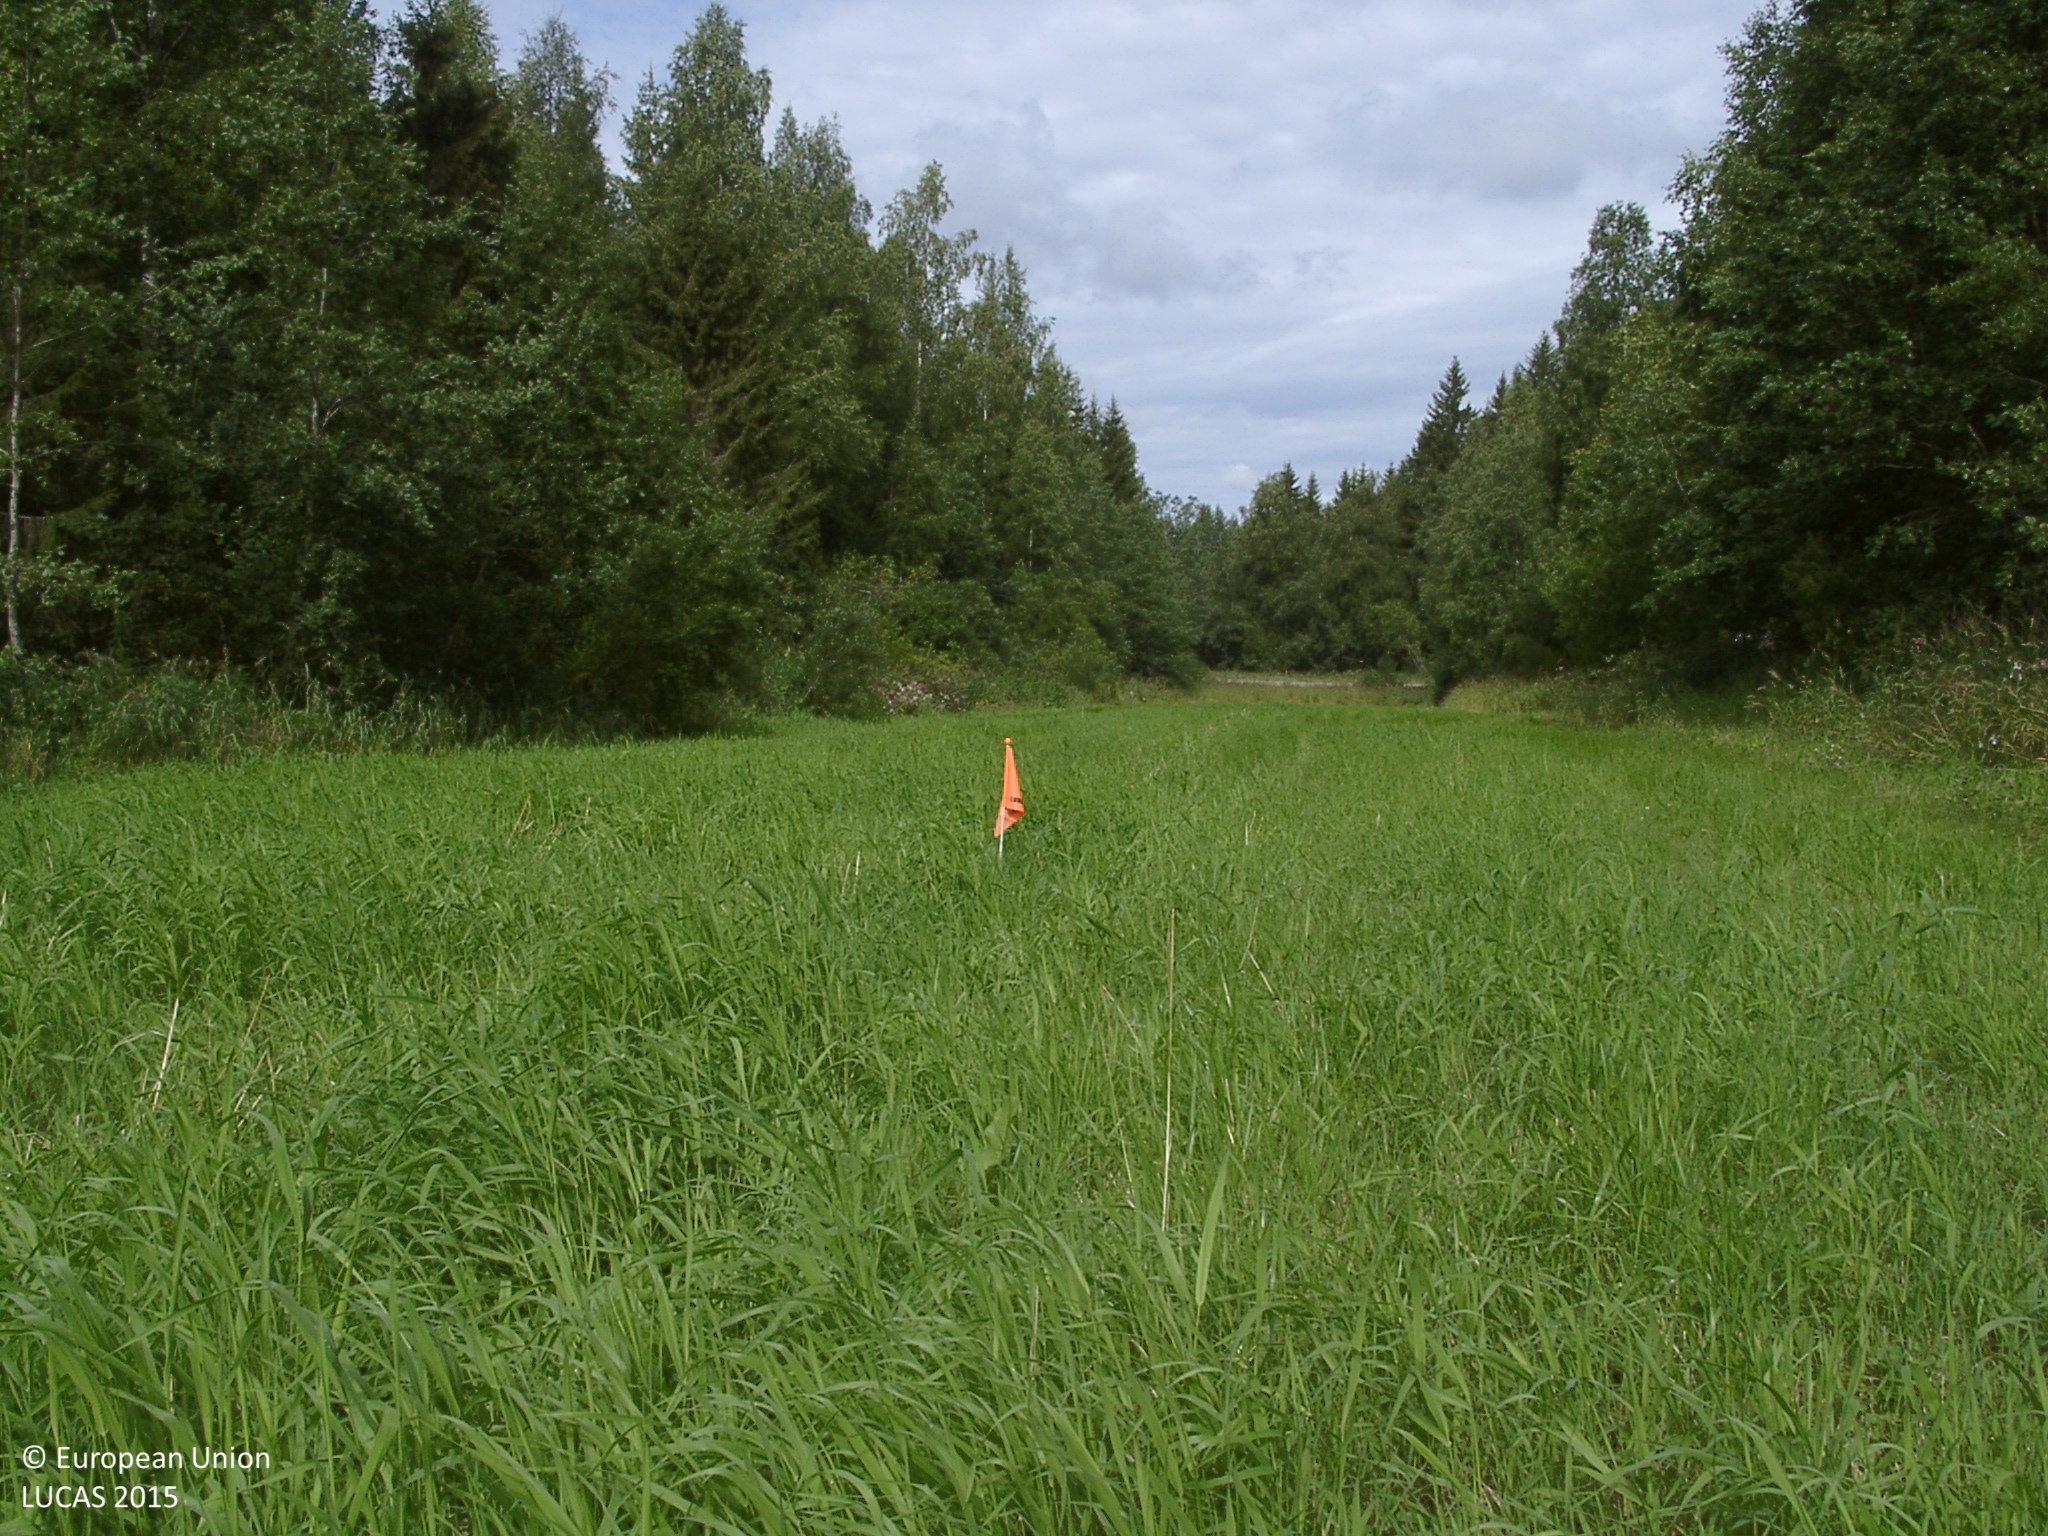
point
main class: Cropland
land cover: Temporary grasslands
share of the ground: > 75 %
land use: Agriculture (excluding fallow land and kitchen gardens)
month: August
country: FI
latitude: 62.4228
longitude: 25.3869
